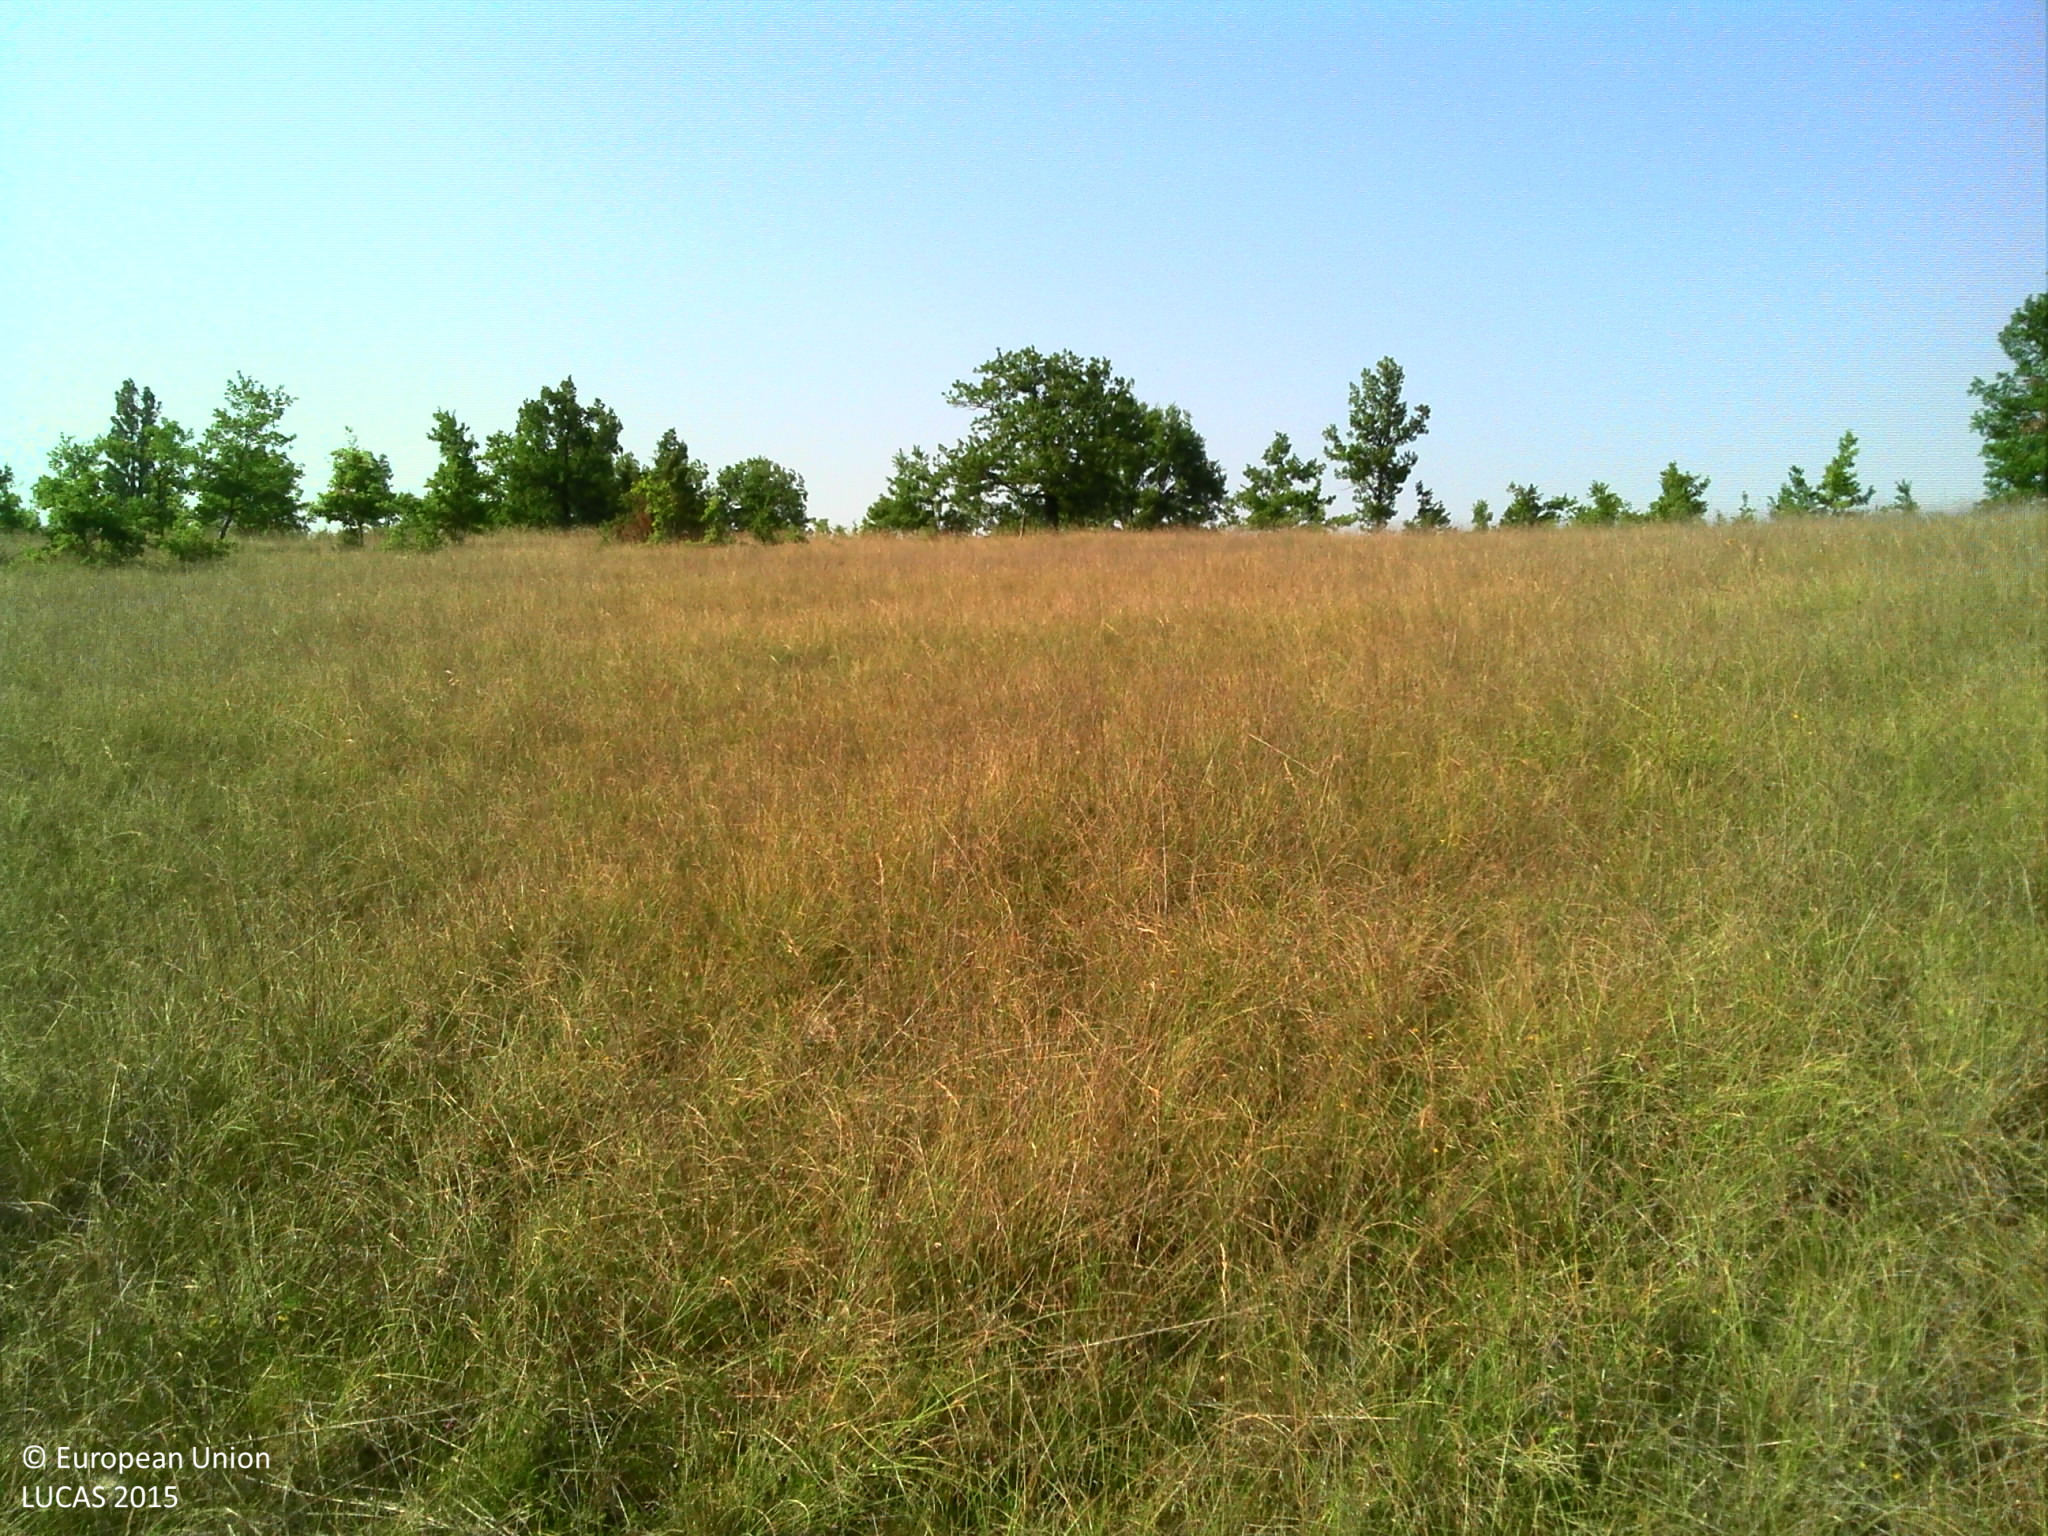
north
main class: Grassland
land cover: Grassland with sparse tree/shrub cover
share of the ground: > 75 %
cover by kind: herbaceous plants 90 %, broadleaved forest trees 5 %, shrubs 5 %
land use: Agriculture (excluding fallow land and kitchen gardens)
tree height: < 5 m
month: July
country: FR
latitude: 44.4229
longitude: 0.9141
